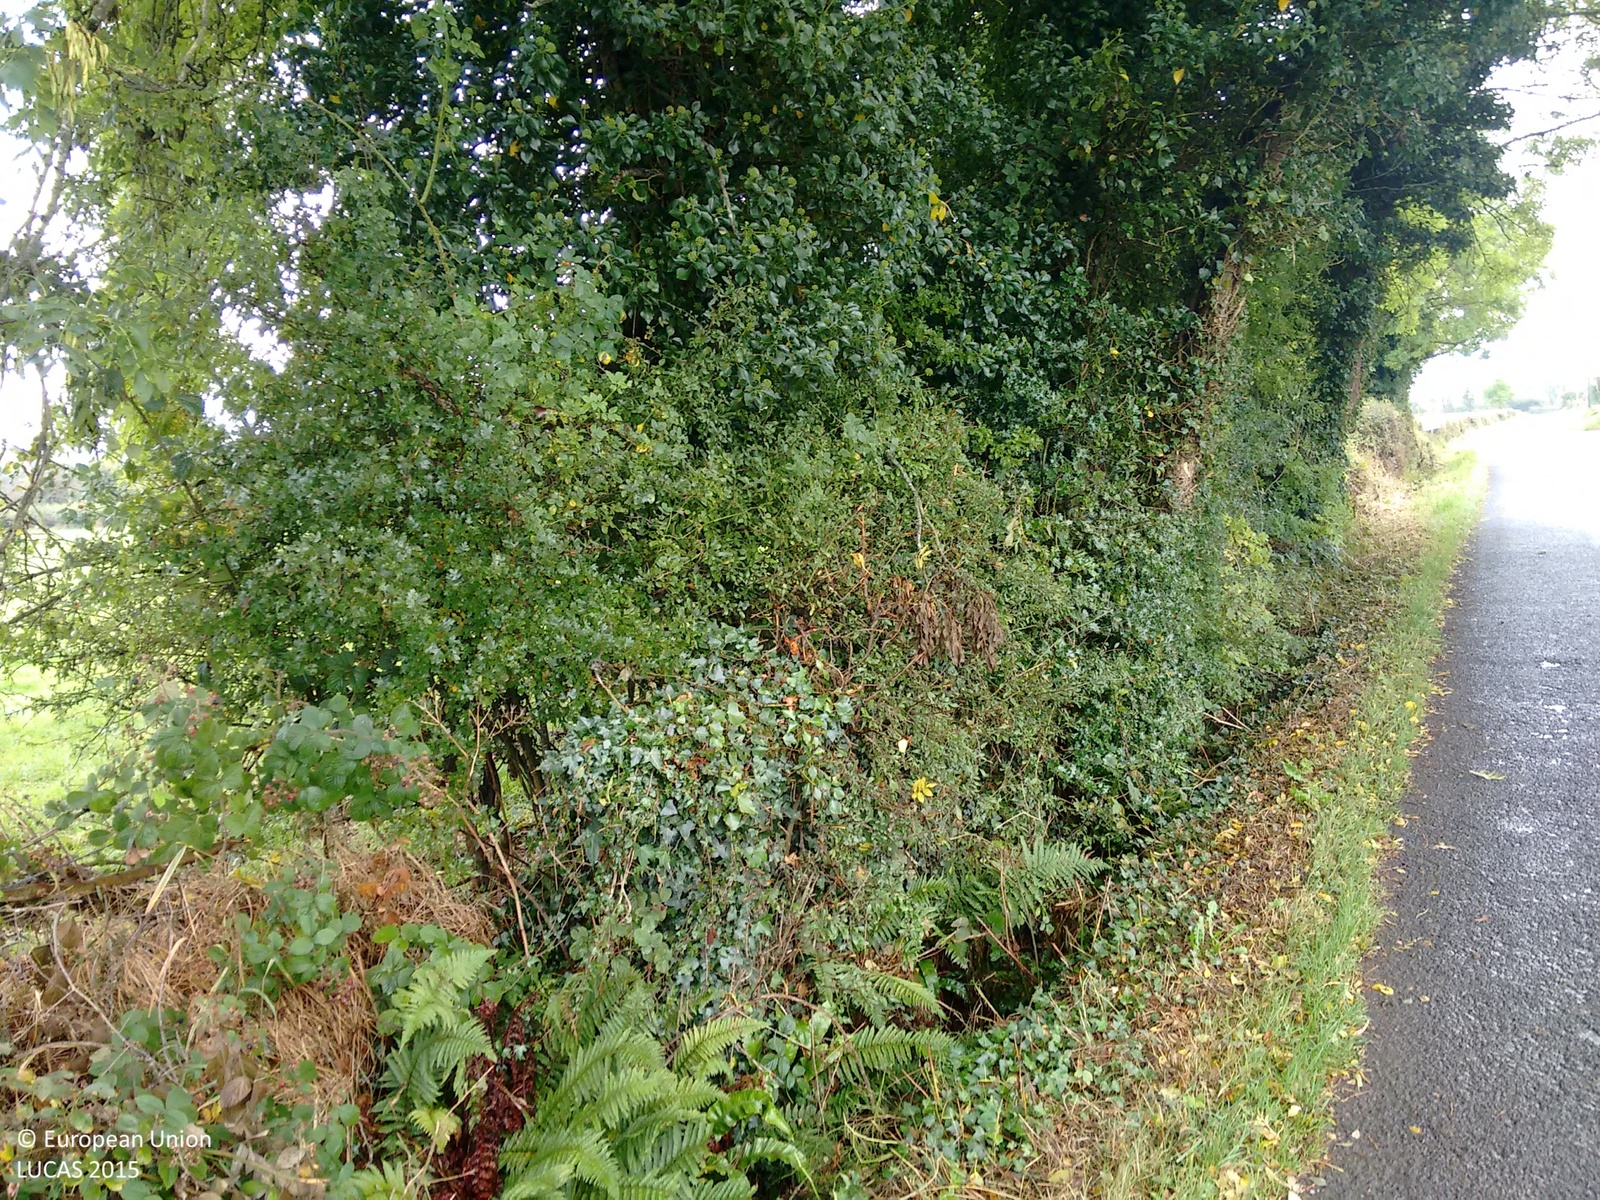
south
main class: Grassland
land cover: Grassland without tree/shrub cover
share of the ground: > 75 %
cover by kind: herbaceous plants 100 %
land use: Agriculture (excluding fallow land and kitchen gardens)
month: October
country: IE
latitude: 53.7927
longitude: -7.9804
